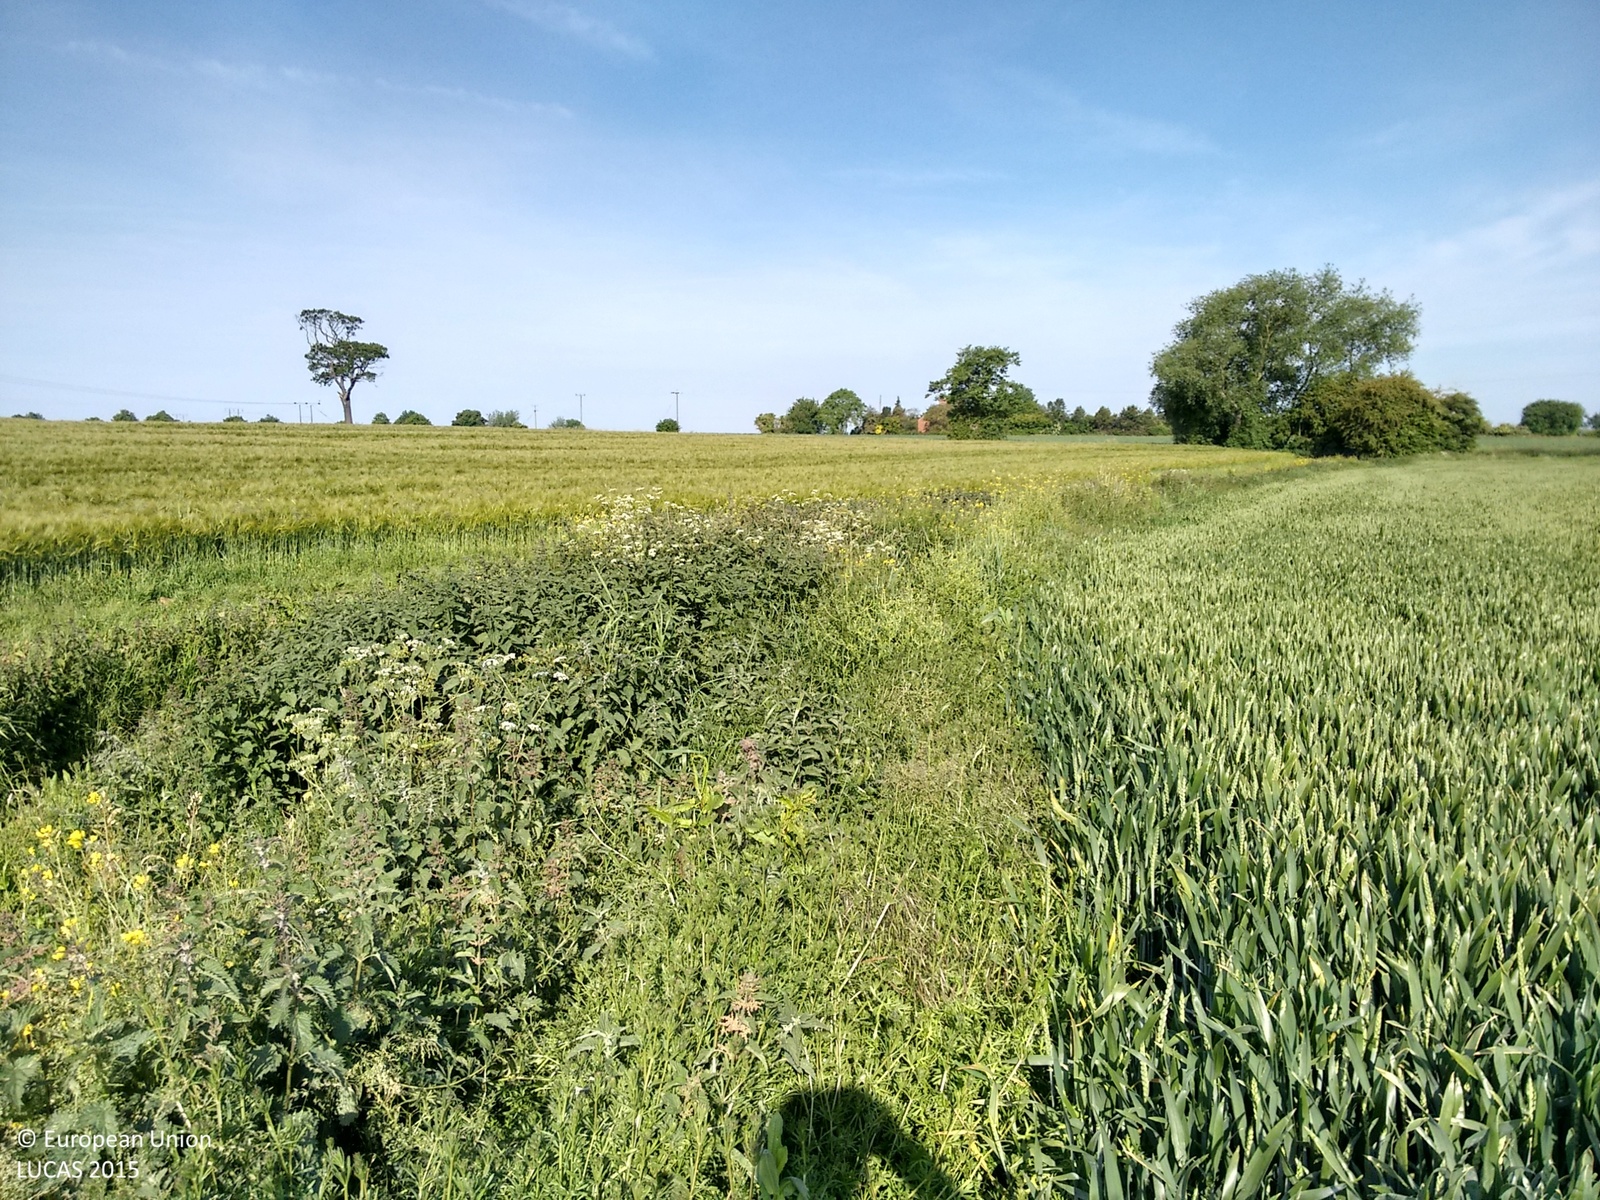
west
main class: Cropland
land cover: Common wheat
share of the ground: > 75 %
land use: Agriculture (excluding fallow land and kitchen gardens)
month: June
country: GB
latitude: 53.7993
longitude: -1.0818
